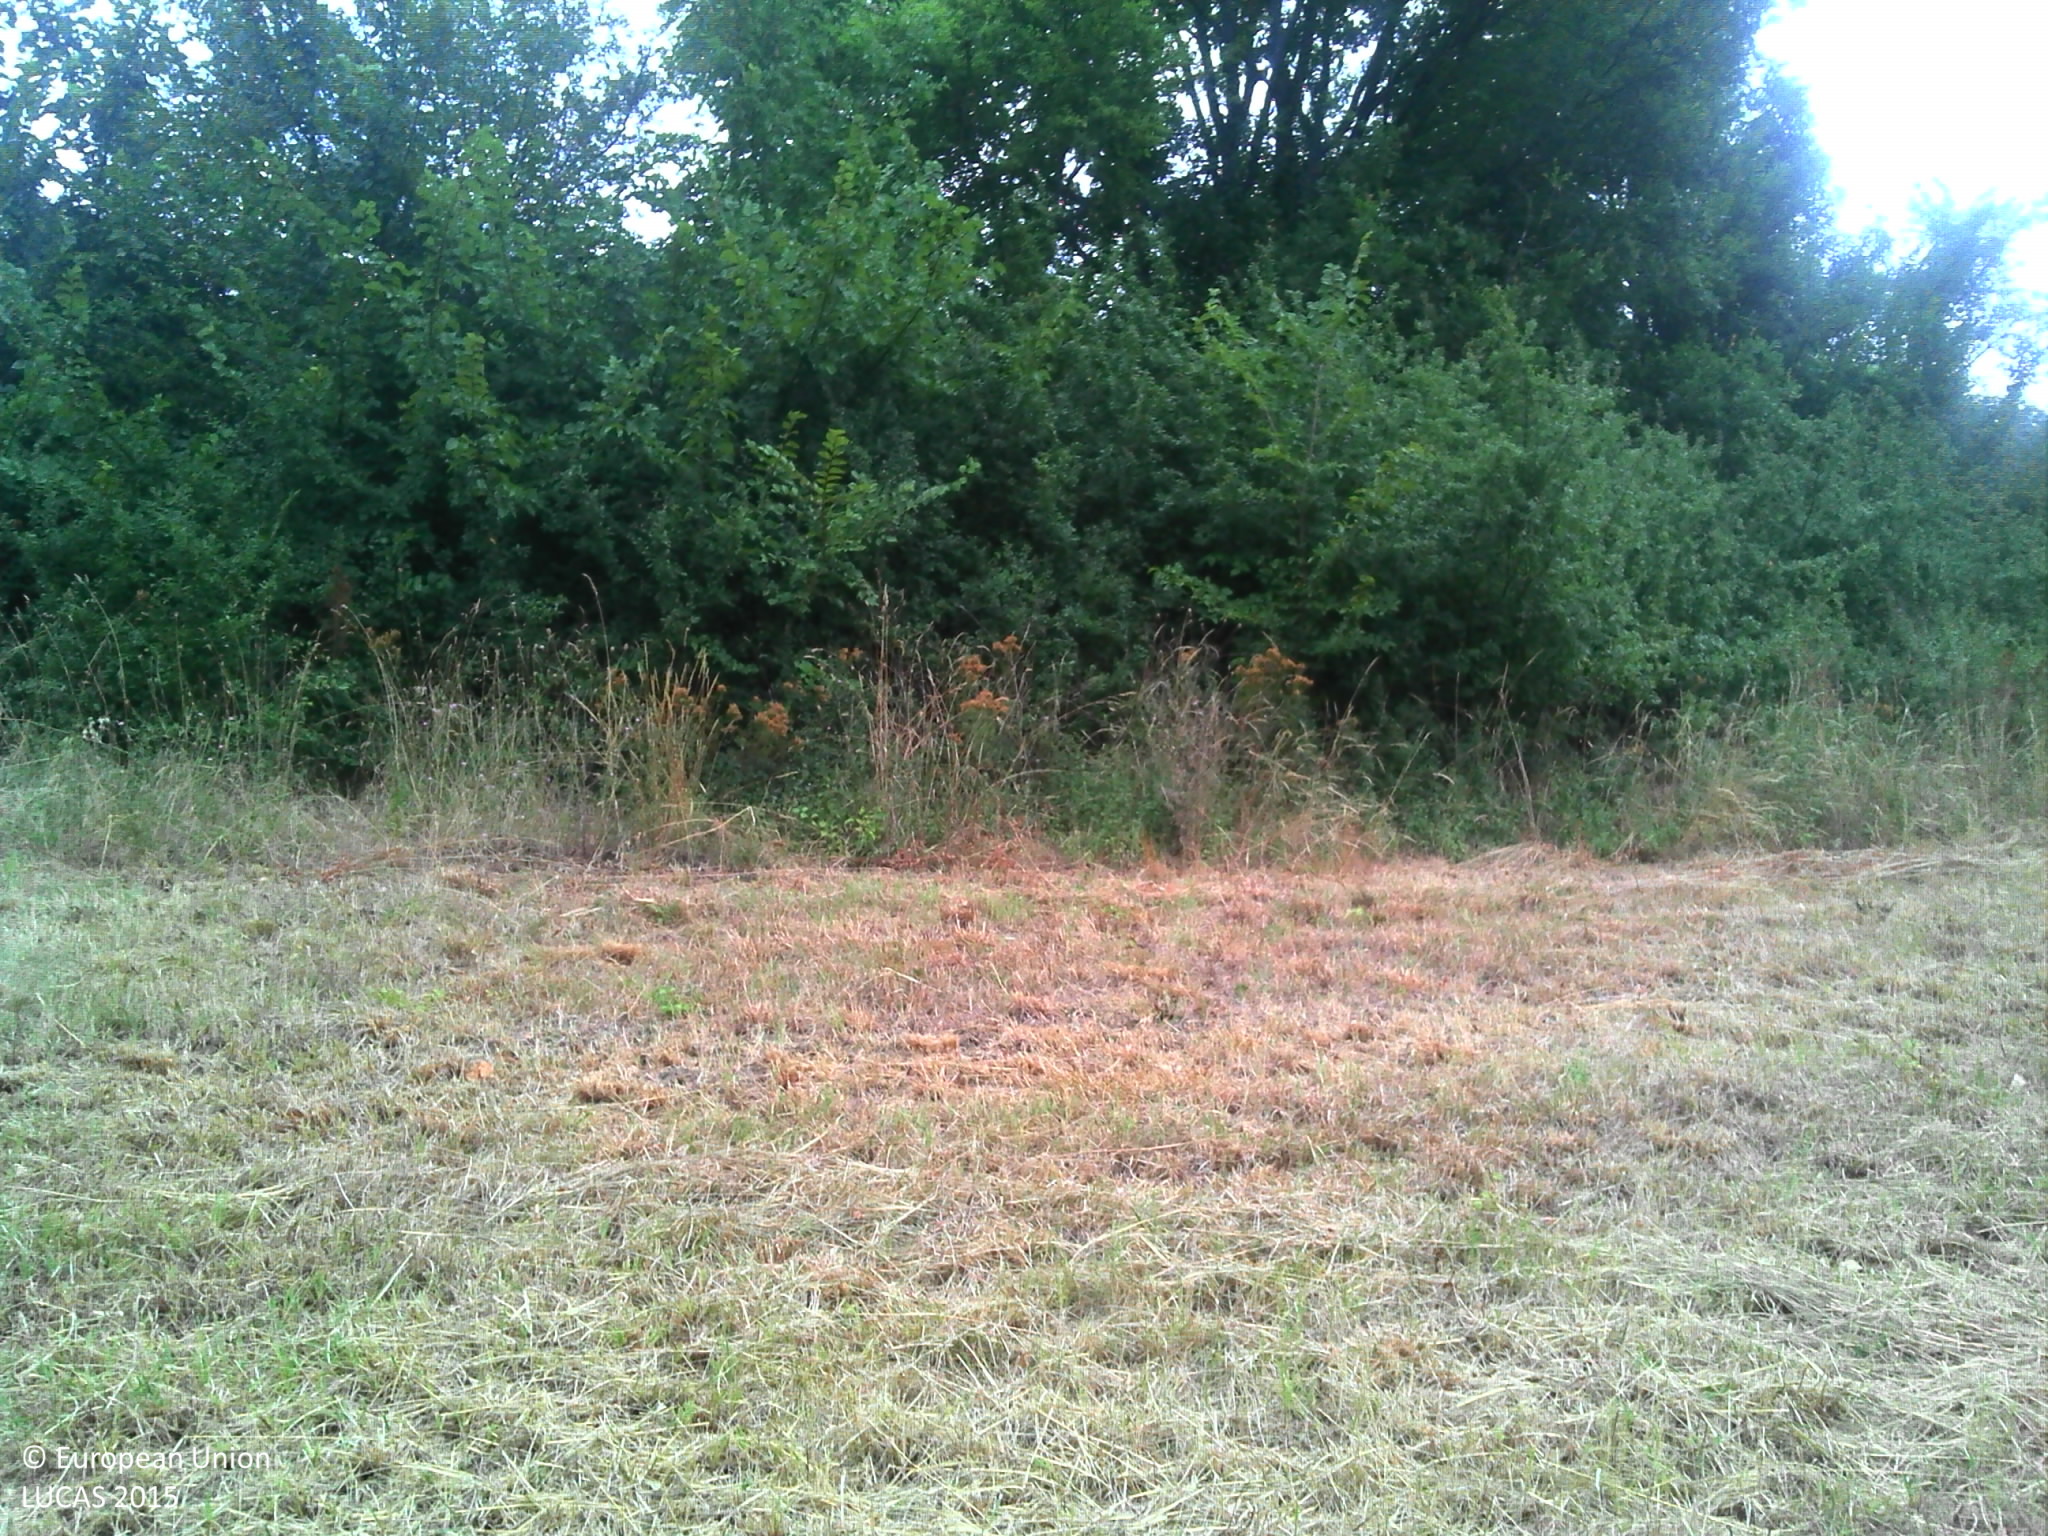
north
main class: Grassland
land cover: Grassland without tree/shrub cover
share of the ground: > 75 %
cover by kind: herbaceous plants 100 %
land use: Agriculture (excluding fallow land and kitchen gardens)
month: July
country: FR
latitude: 44.2082
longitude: 0.9485
